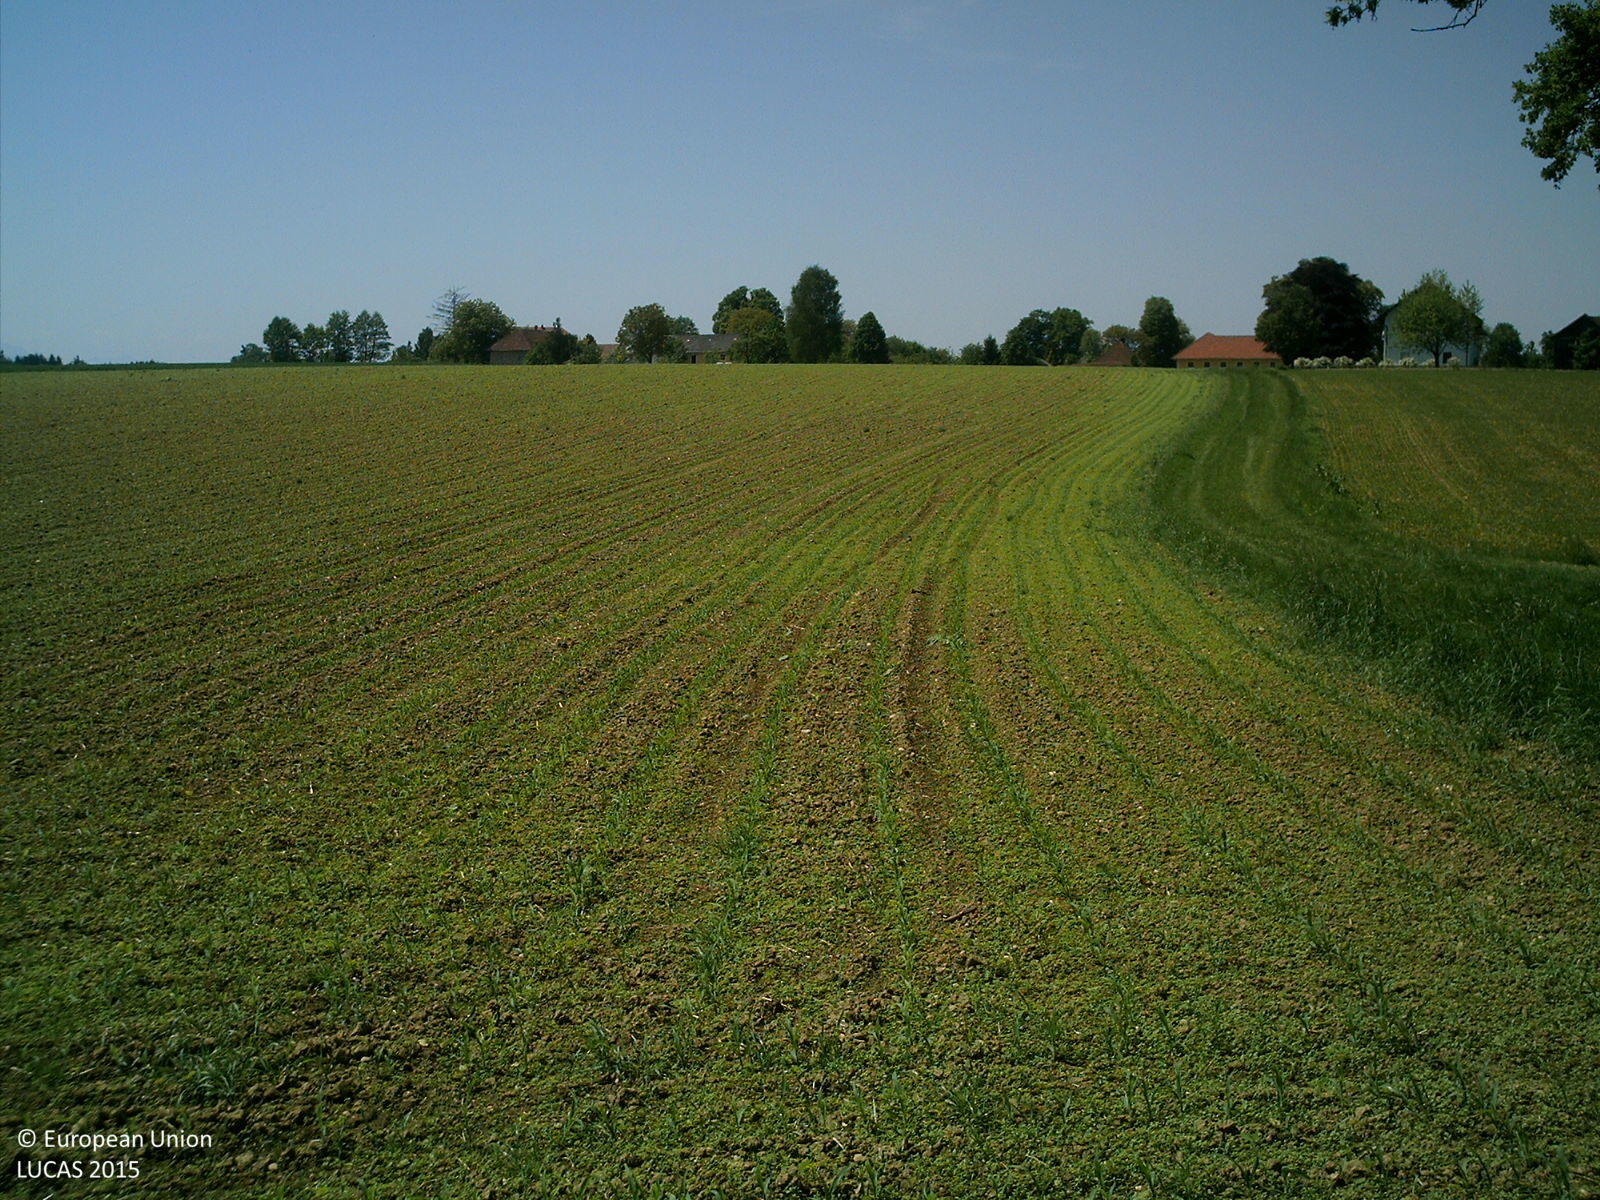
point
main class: Cropland
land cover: Maize
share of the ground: < 10 %
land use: Agriculture (excluding fallow land and kitchen gardens)
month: May
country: AT
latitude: 48.0246
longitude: 14.0087
